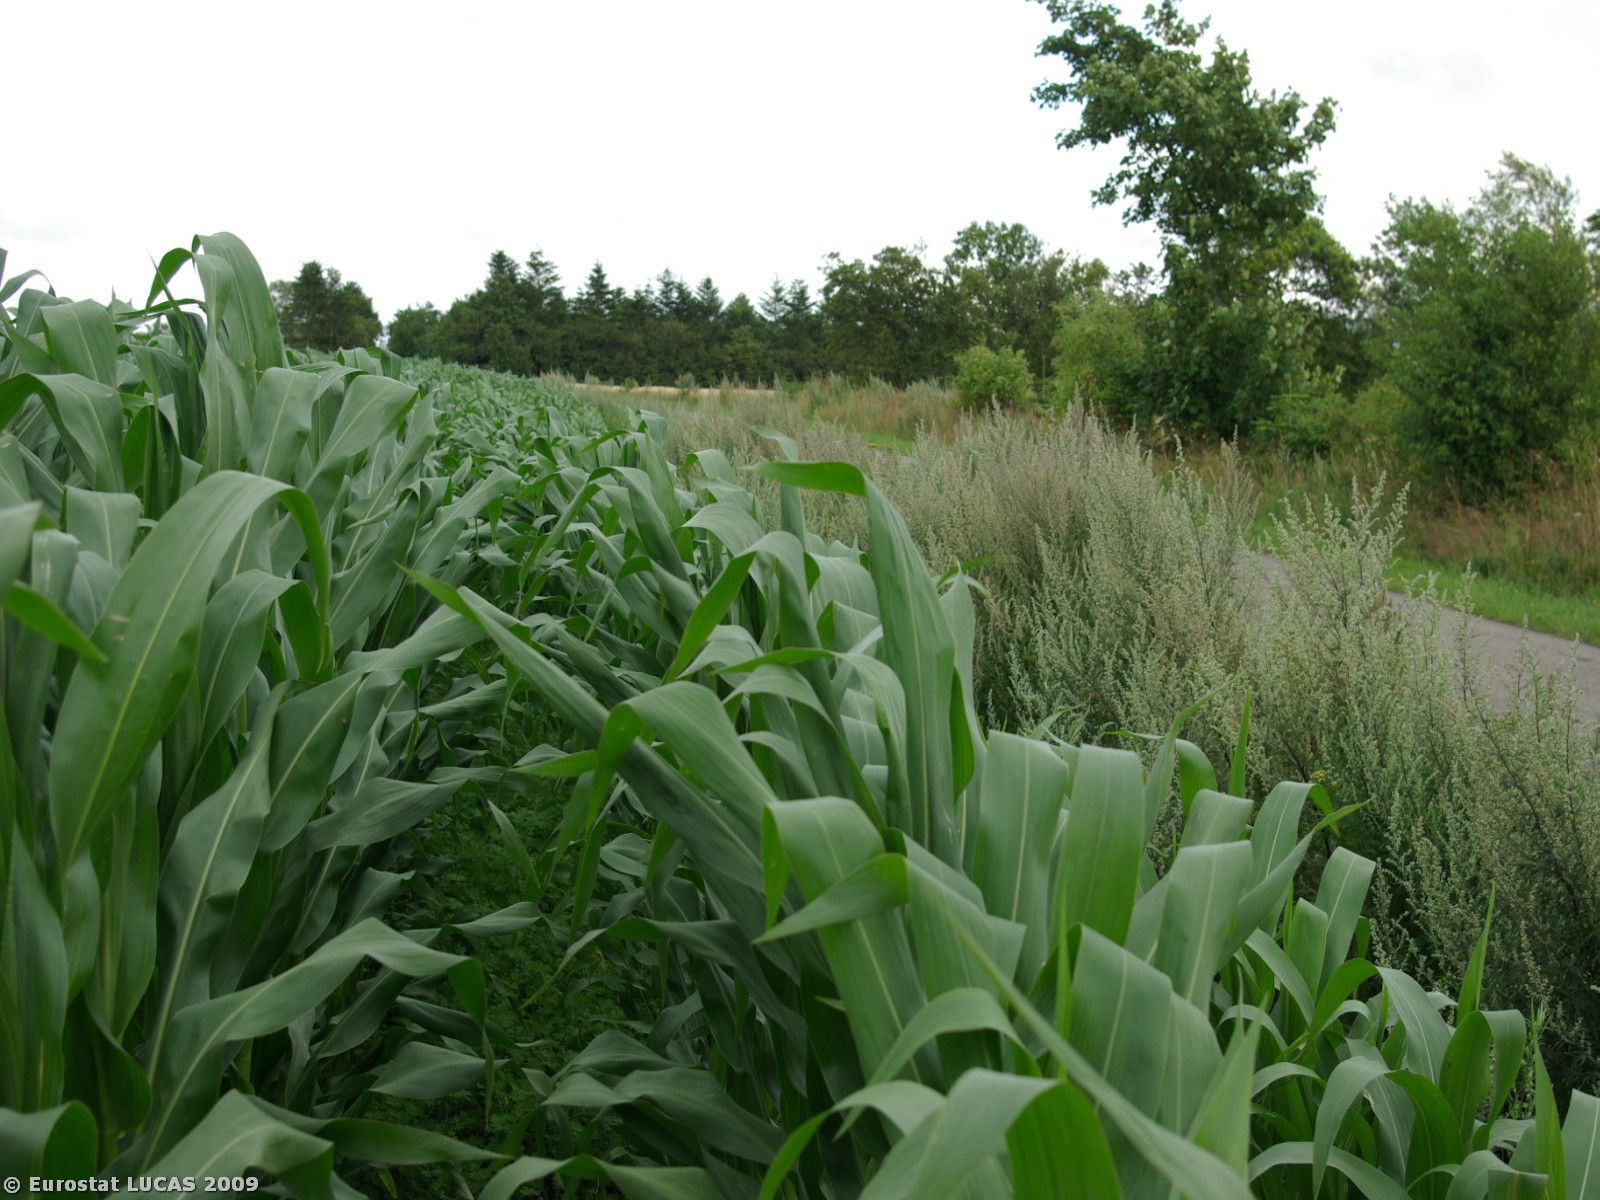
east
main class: Cropland
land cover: Maize
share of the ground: > 75 %
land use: Agriculture (excluding fallow land and kitchen gardens)
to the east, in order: Maize; Shruby margins; Grass margins; Paved roads, cycling and walking lanes; Grass margins; Barley; Grass margins; Tracks; Grass margins; Groves; Coniferous woodland; Tracks; Abandoned hedges; Artificial constructions in urban areas
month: July
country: DK
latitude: 55.2125
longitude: 8.9165
